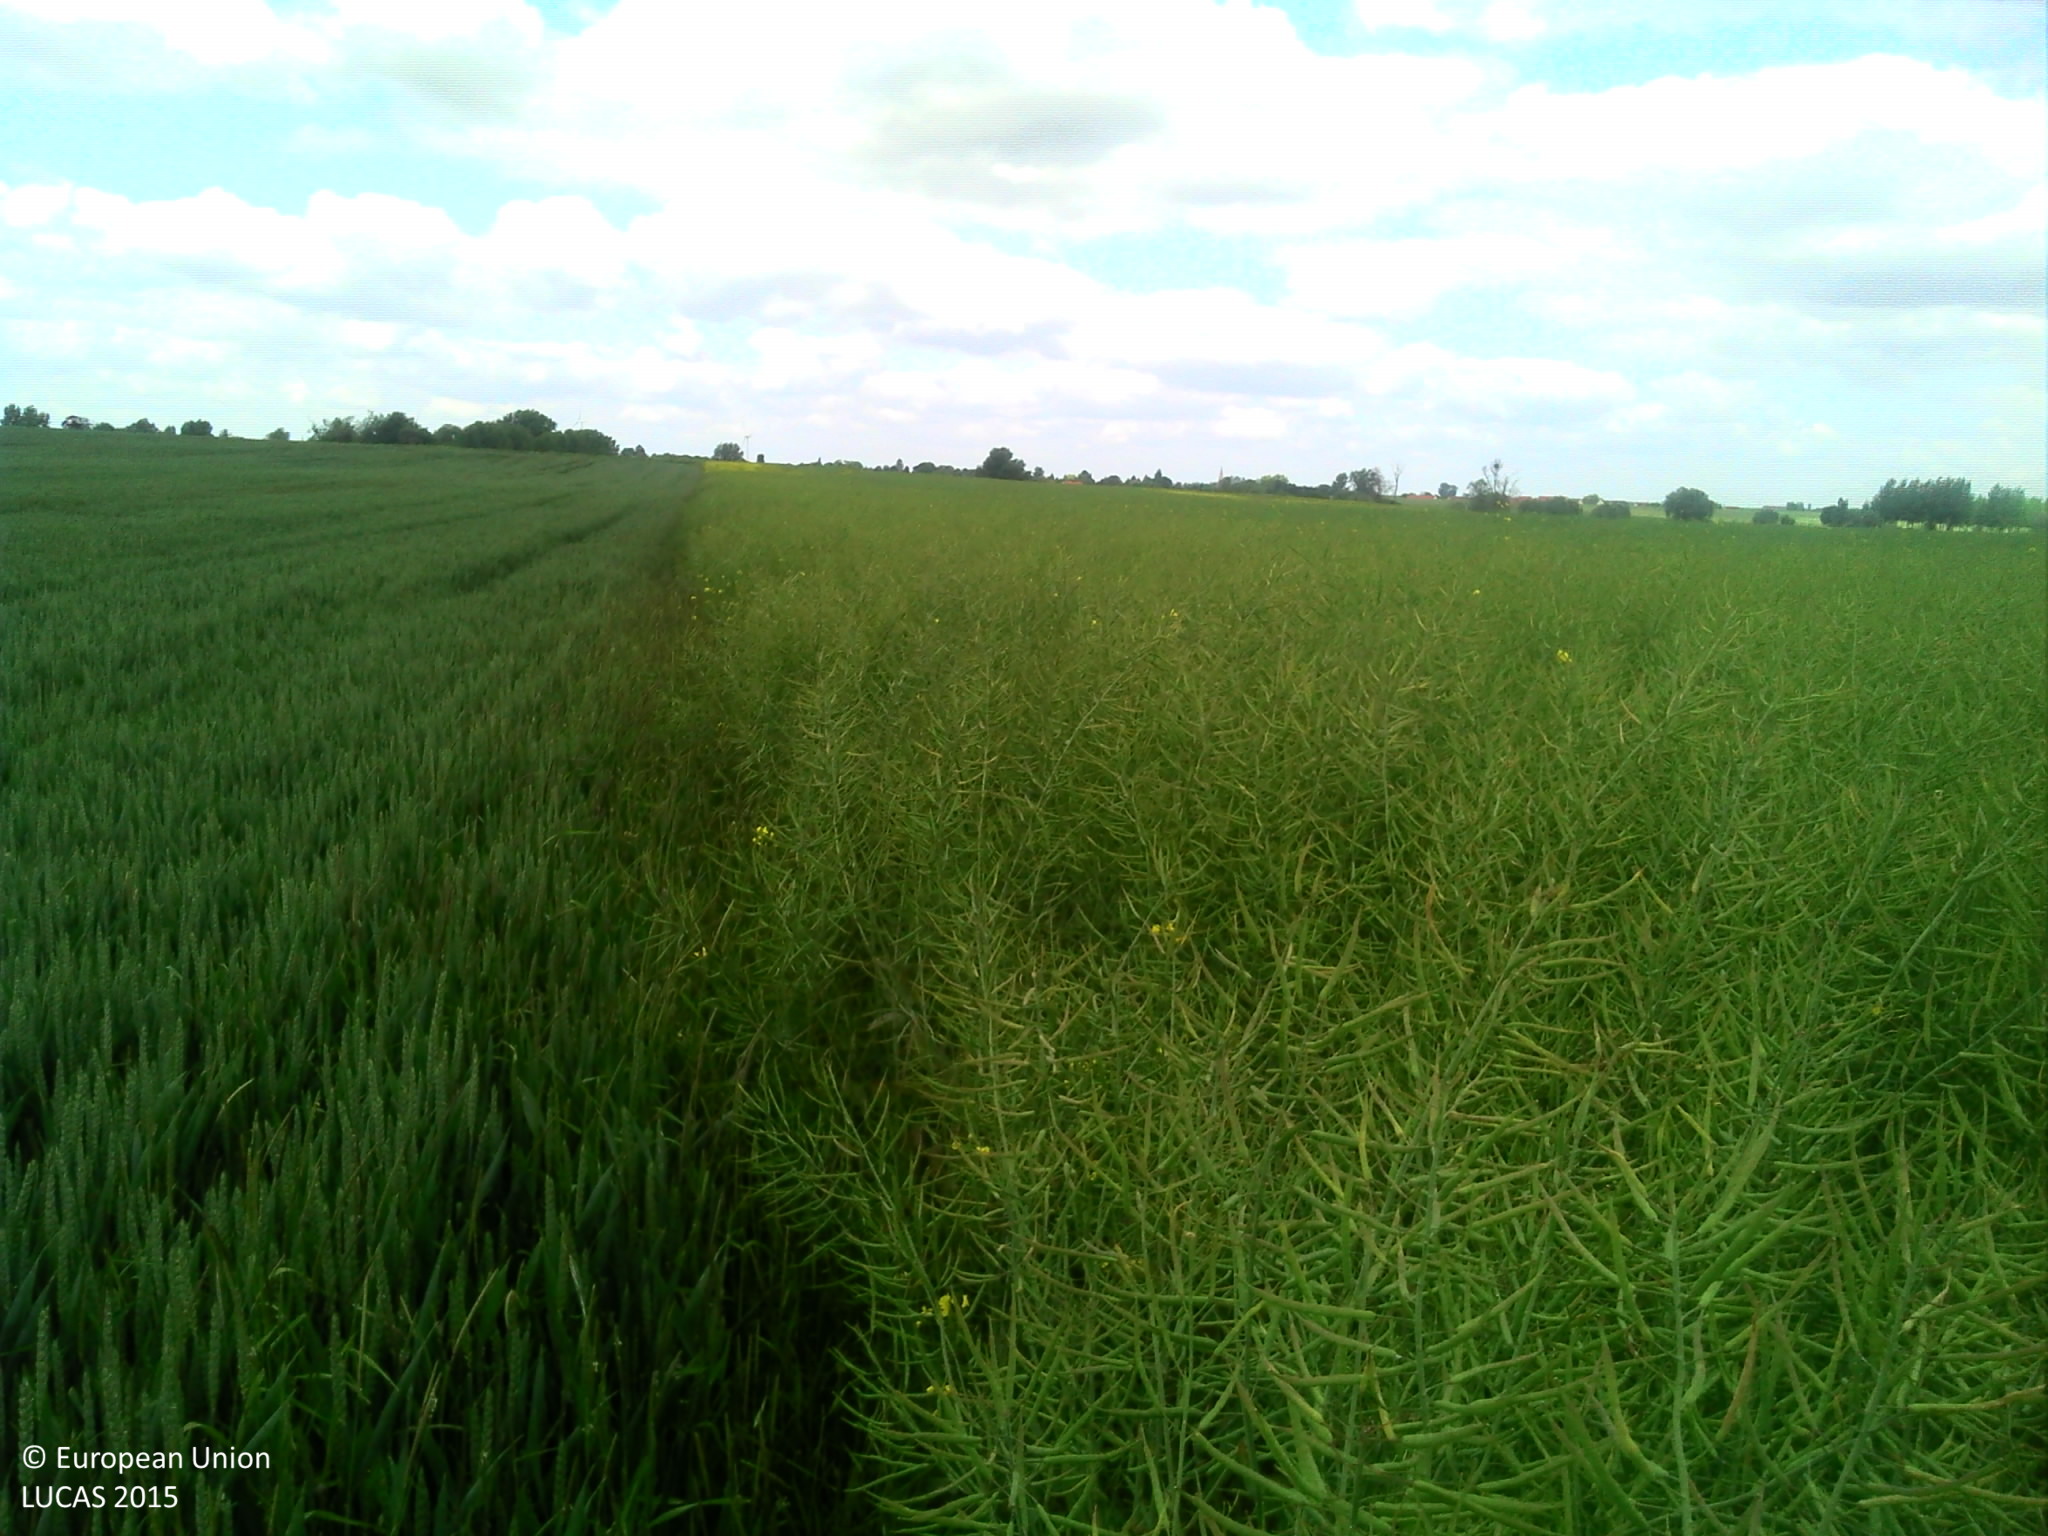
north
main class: Cropland
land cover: Rape and turnip rape
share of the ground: > 75 %
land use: Agriculture (excluding fallow land and kitchen gardens)
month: June
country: FR
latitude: 49.7306
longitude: 3.2351
